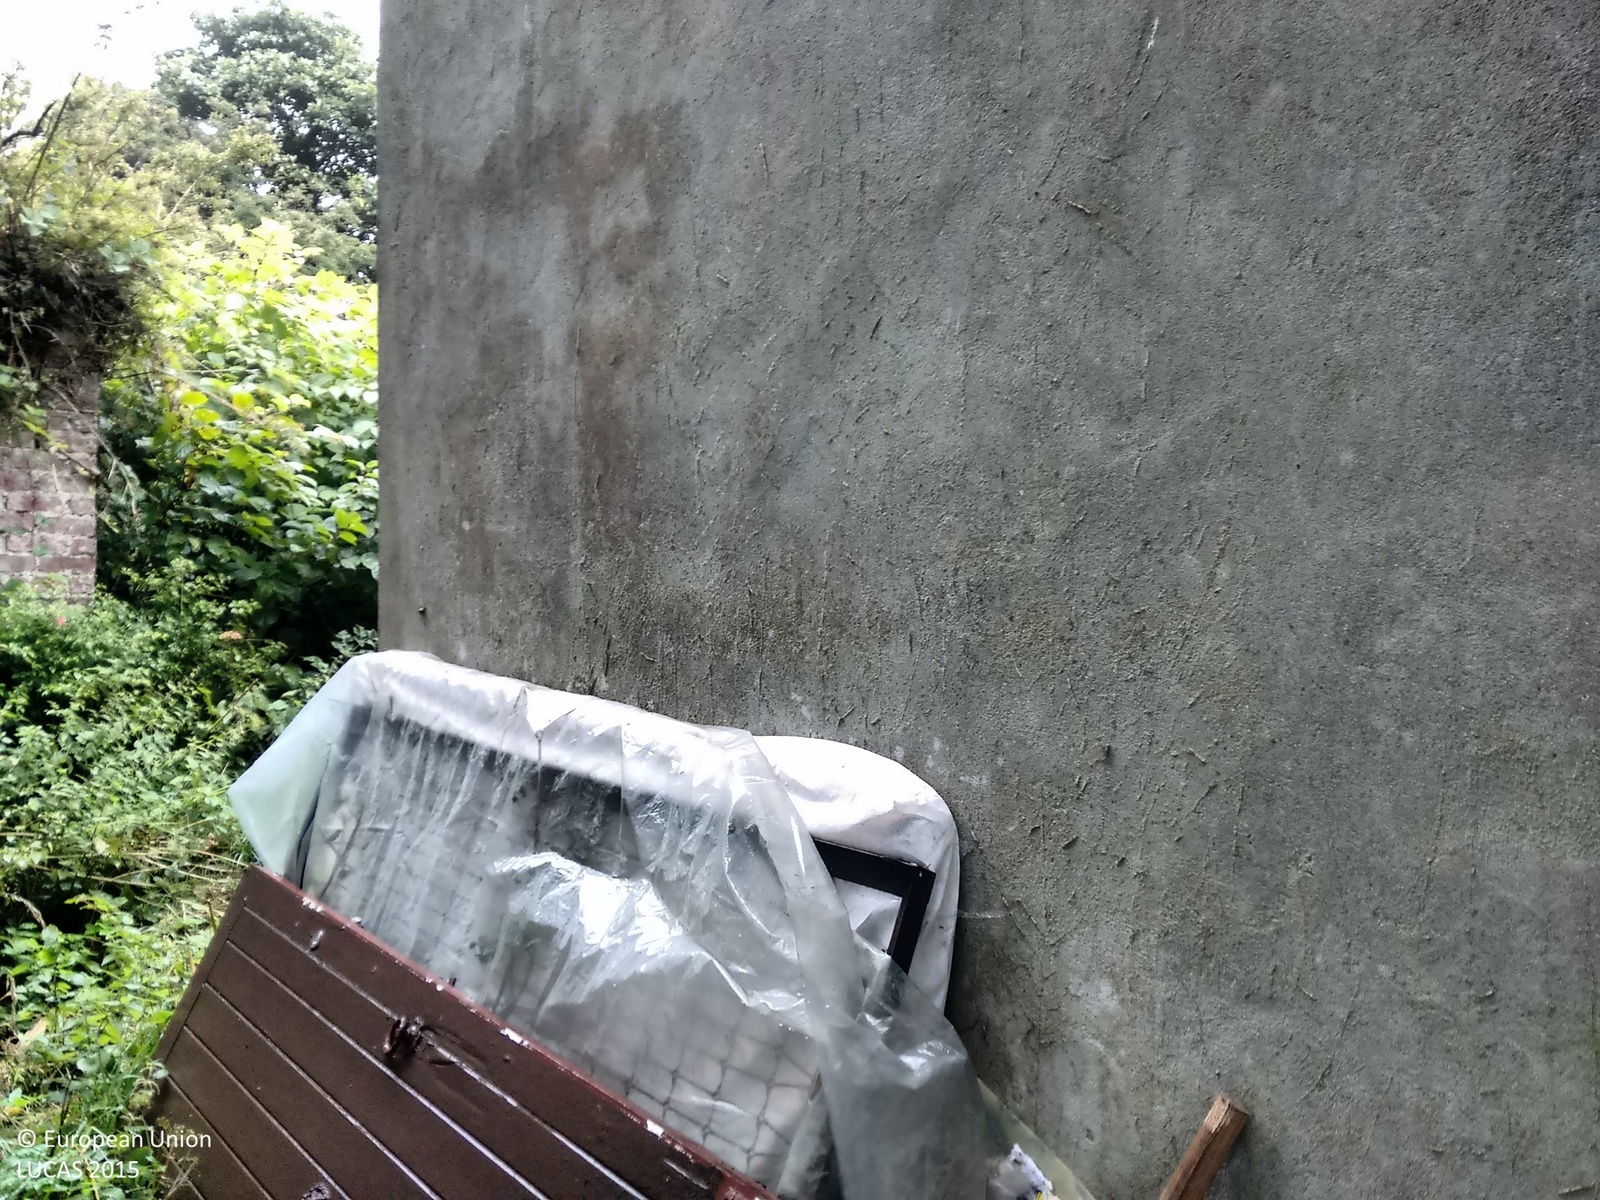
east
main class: Woodland
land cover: Broadleaved woodland
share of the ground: > 75 %
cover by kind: broadleaved forest trees 95 %, herbaceous plants 5 %
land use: Residential
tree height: > 5 m
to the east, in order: Broadleaved woodland; Artificial constructions in urban areas; Fences; Grassland without tree/shrub cover; Electric lines; Grassland without tree/shrub cover; Fences; Grassland without tree/shrub cover
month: August
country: IE
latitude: 52.4836
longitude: -6.3356
